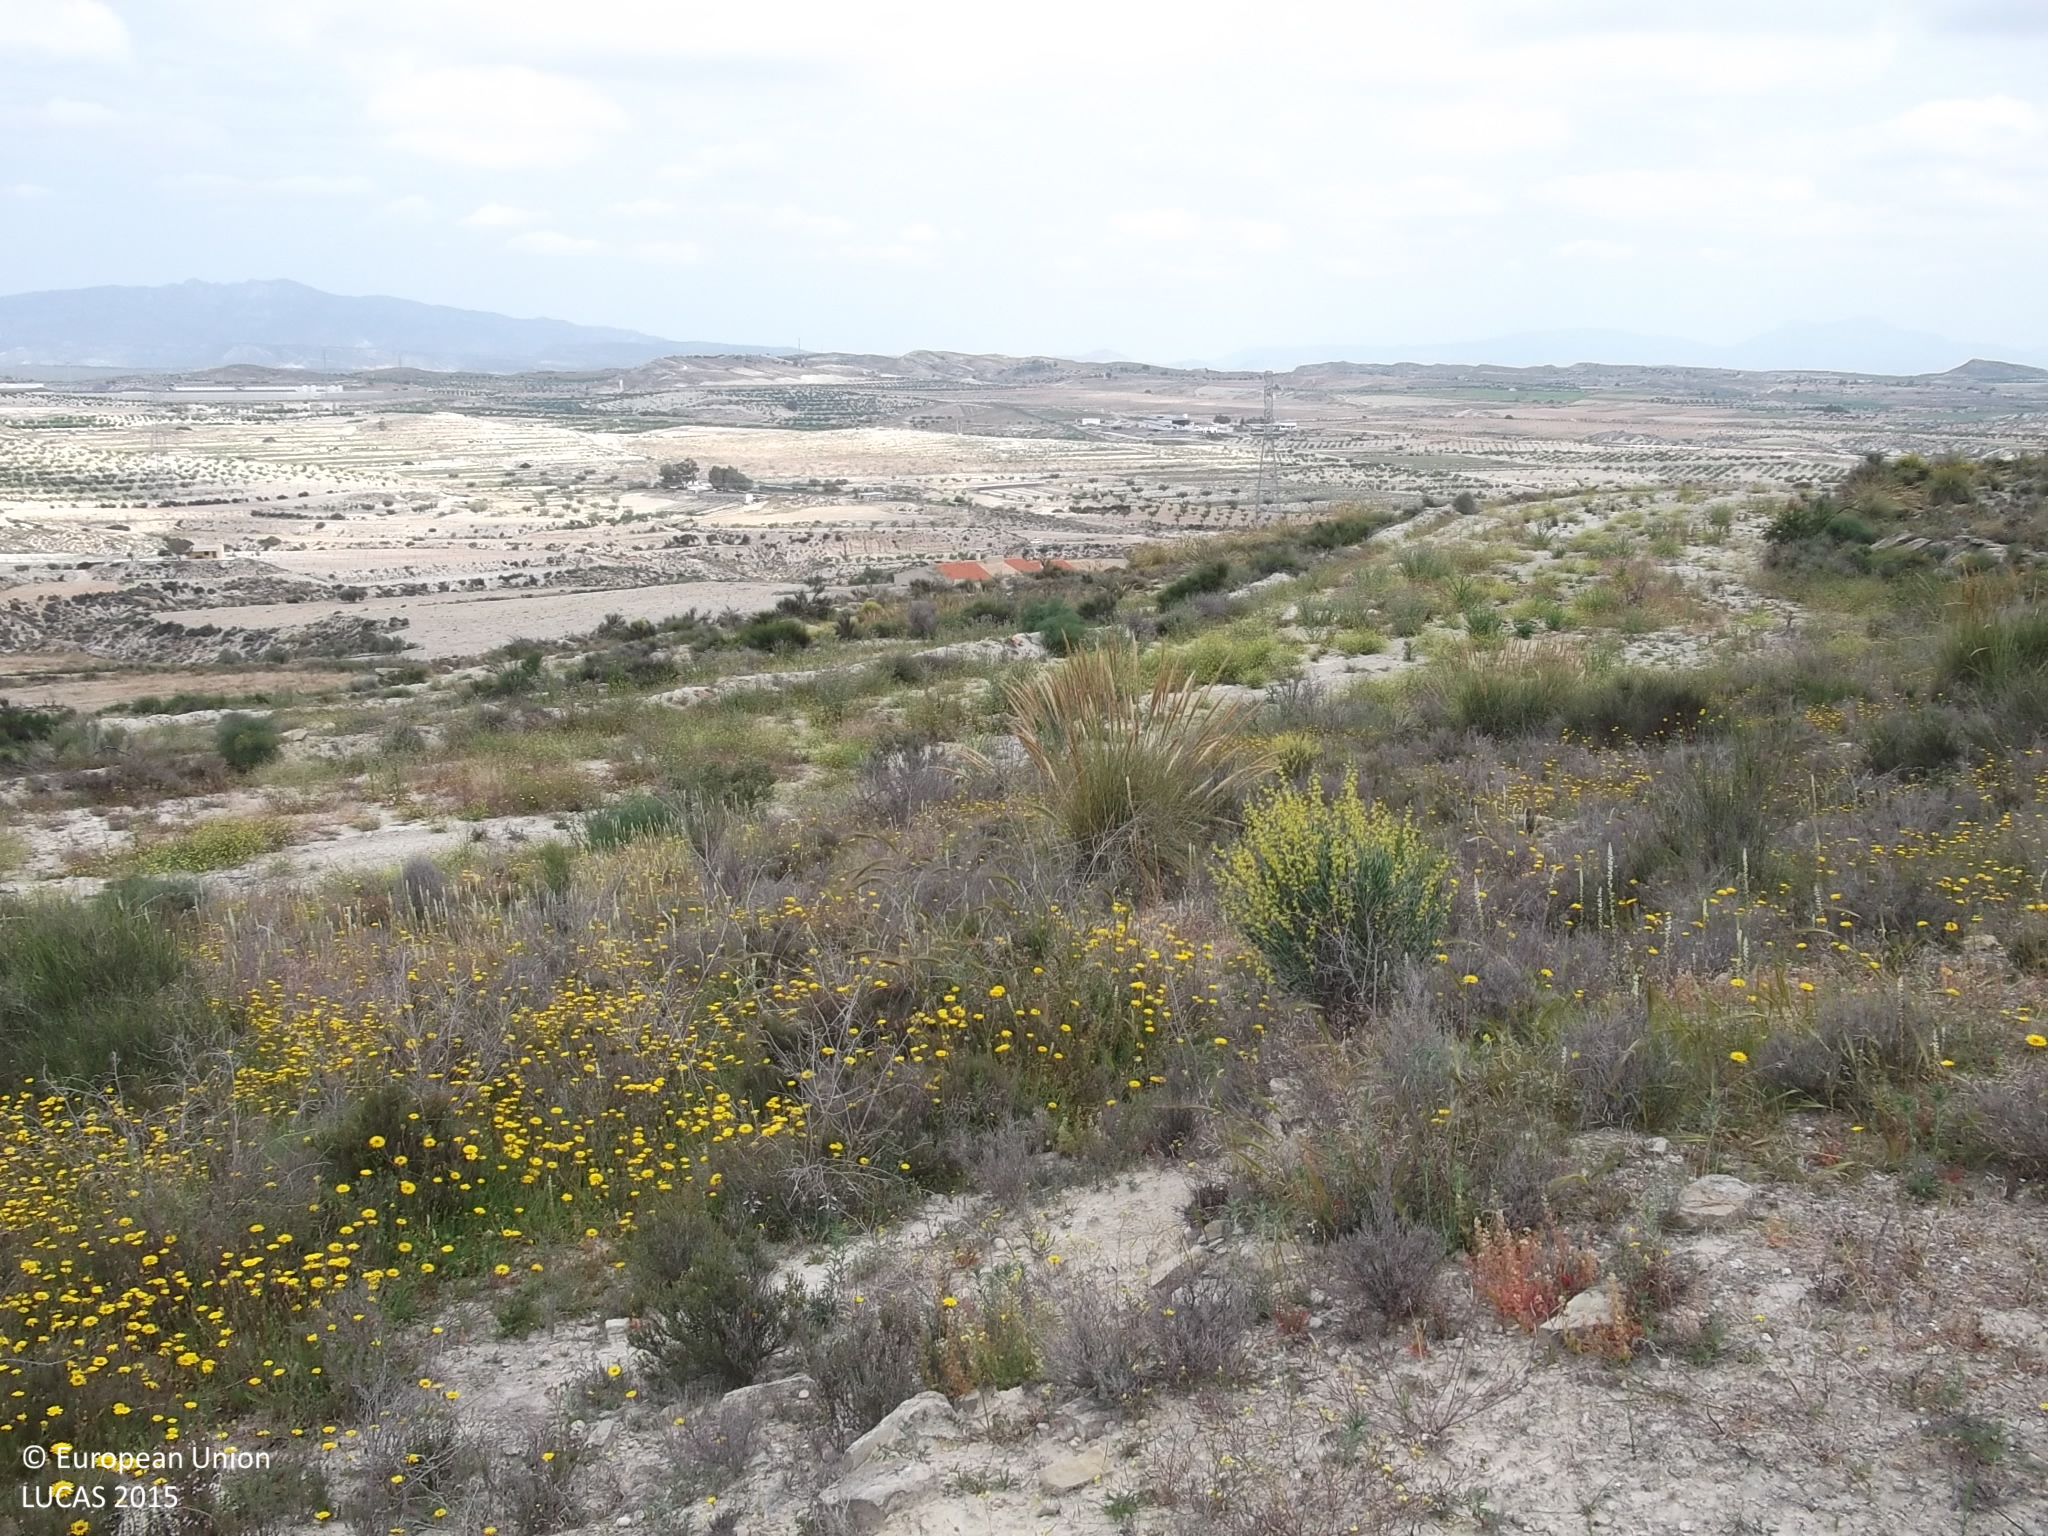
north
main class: Shrubland
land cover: Shrubland without tree cover
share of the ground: 25 - 50 %
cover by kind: herbaceous plants 60 %, shrubs 40 %
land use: Semi-natural and natural areas not in use
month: April
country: ES
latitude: 37.9767
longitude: -1.3806
